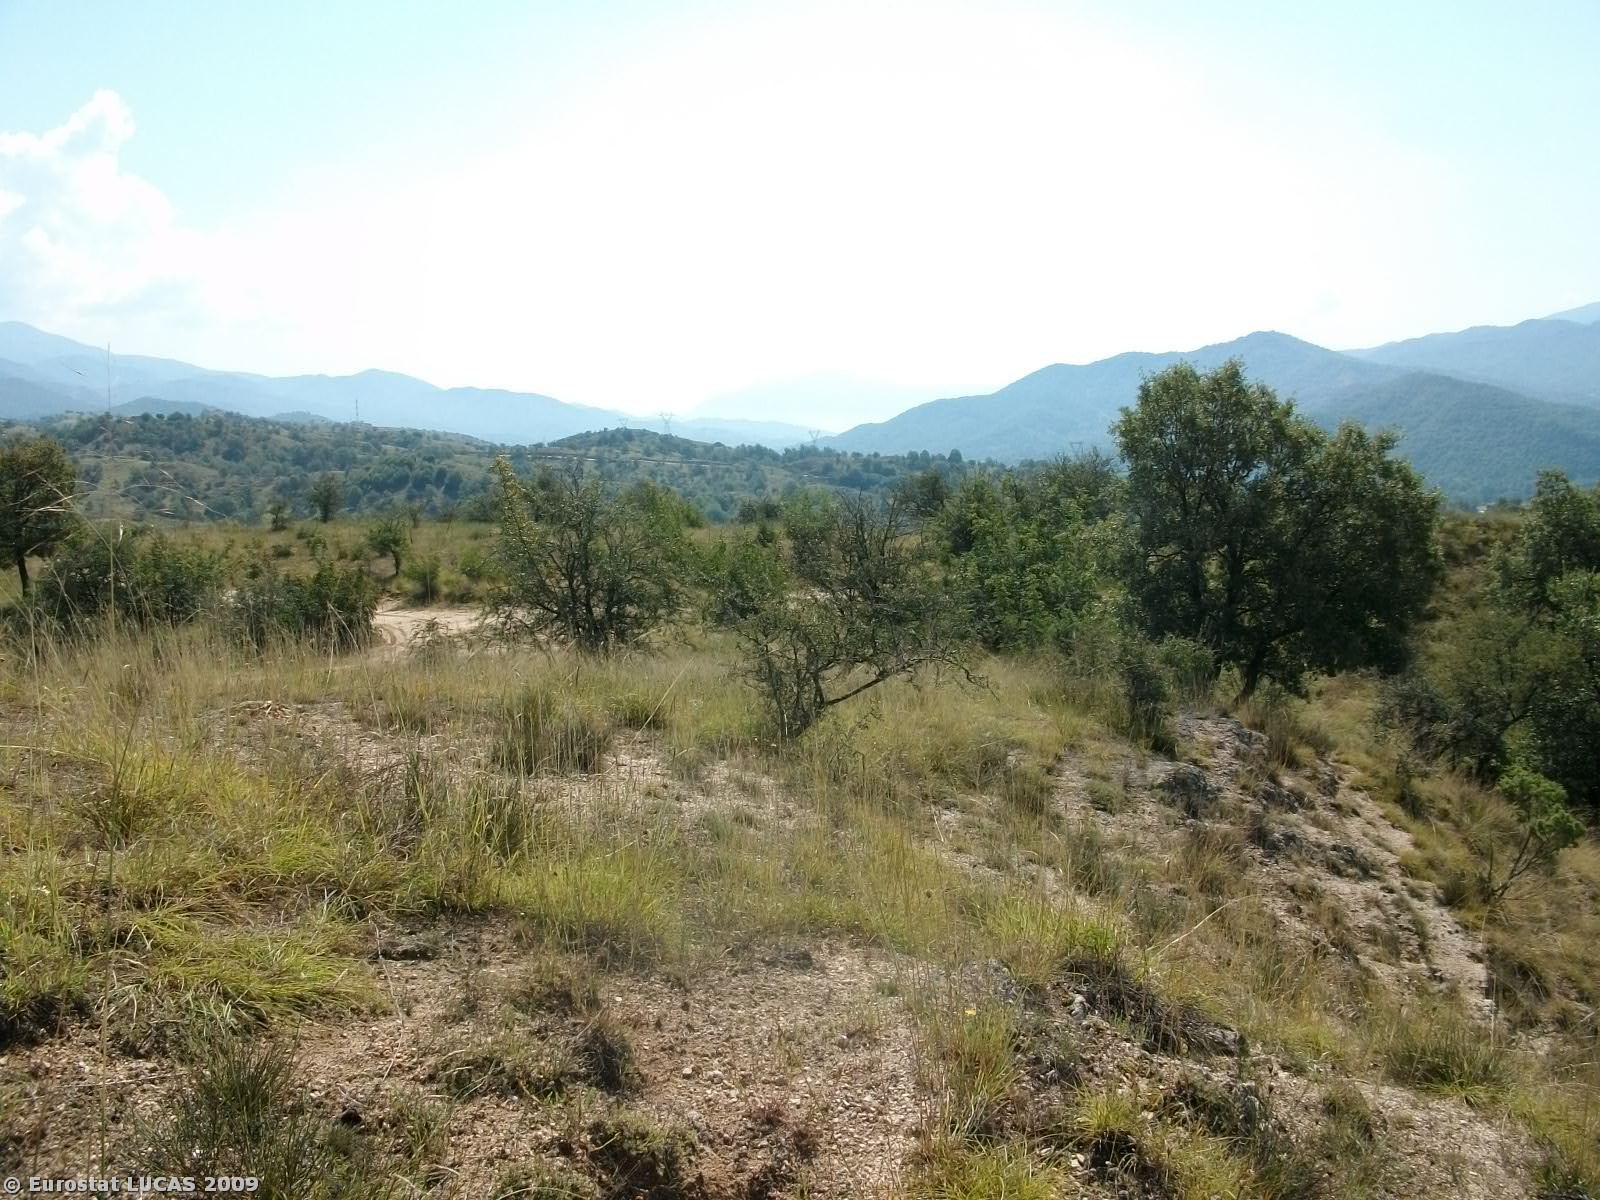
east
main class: Shrubland
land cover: Shrubland with sparse tree cover
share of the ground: > 75 %
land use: Unused
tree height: < 5 m
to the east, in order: Shrubland with sparse tree cover; Broadleaved woodland; Shrubland with sparse tree cover; Paved roads, cycling and walking lanes; Grassland with sparse tree/shrub cover
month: August
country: GR
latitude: 41.2754
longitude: 24.4938
